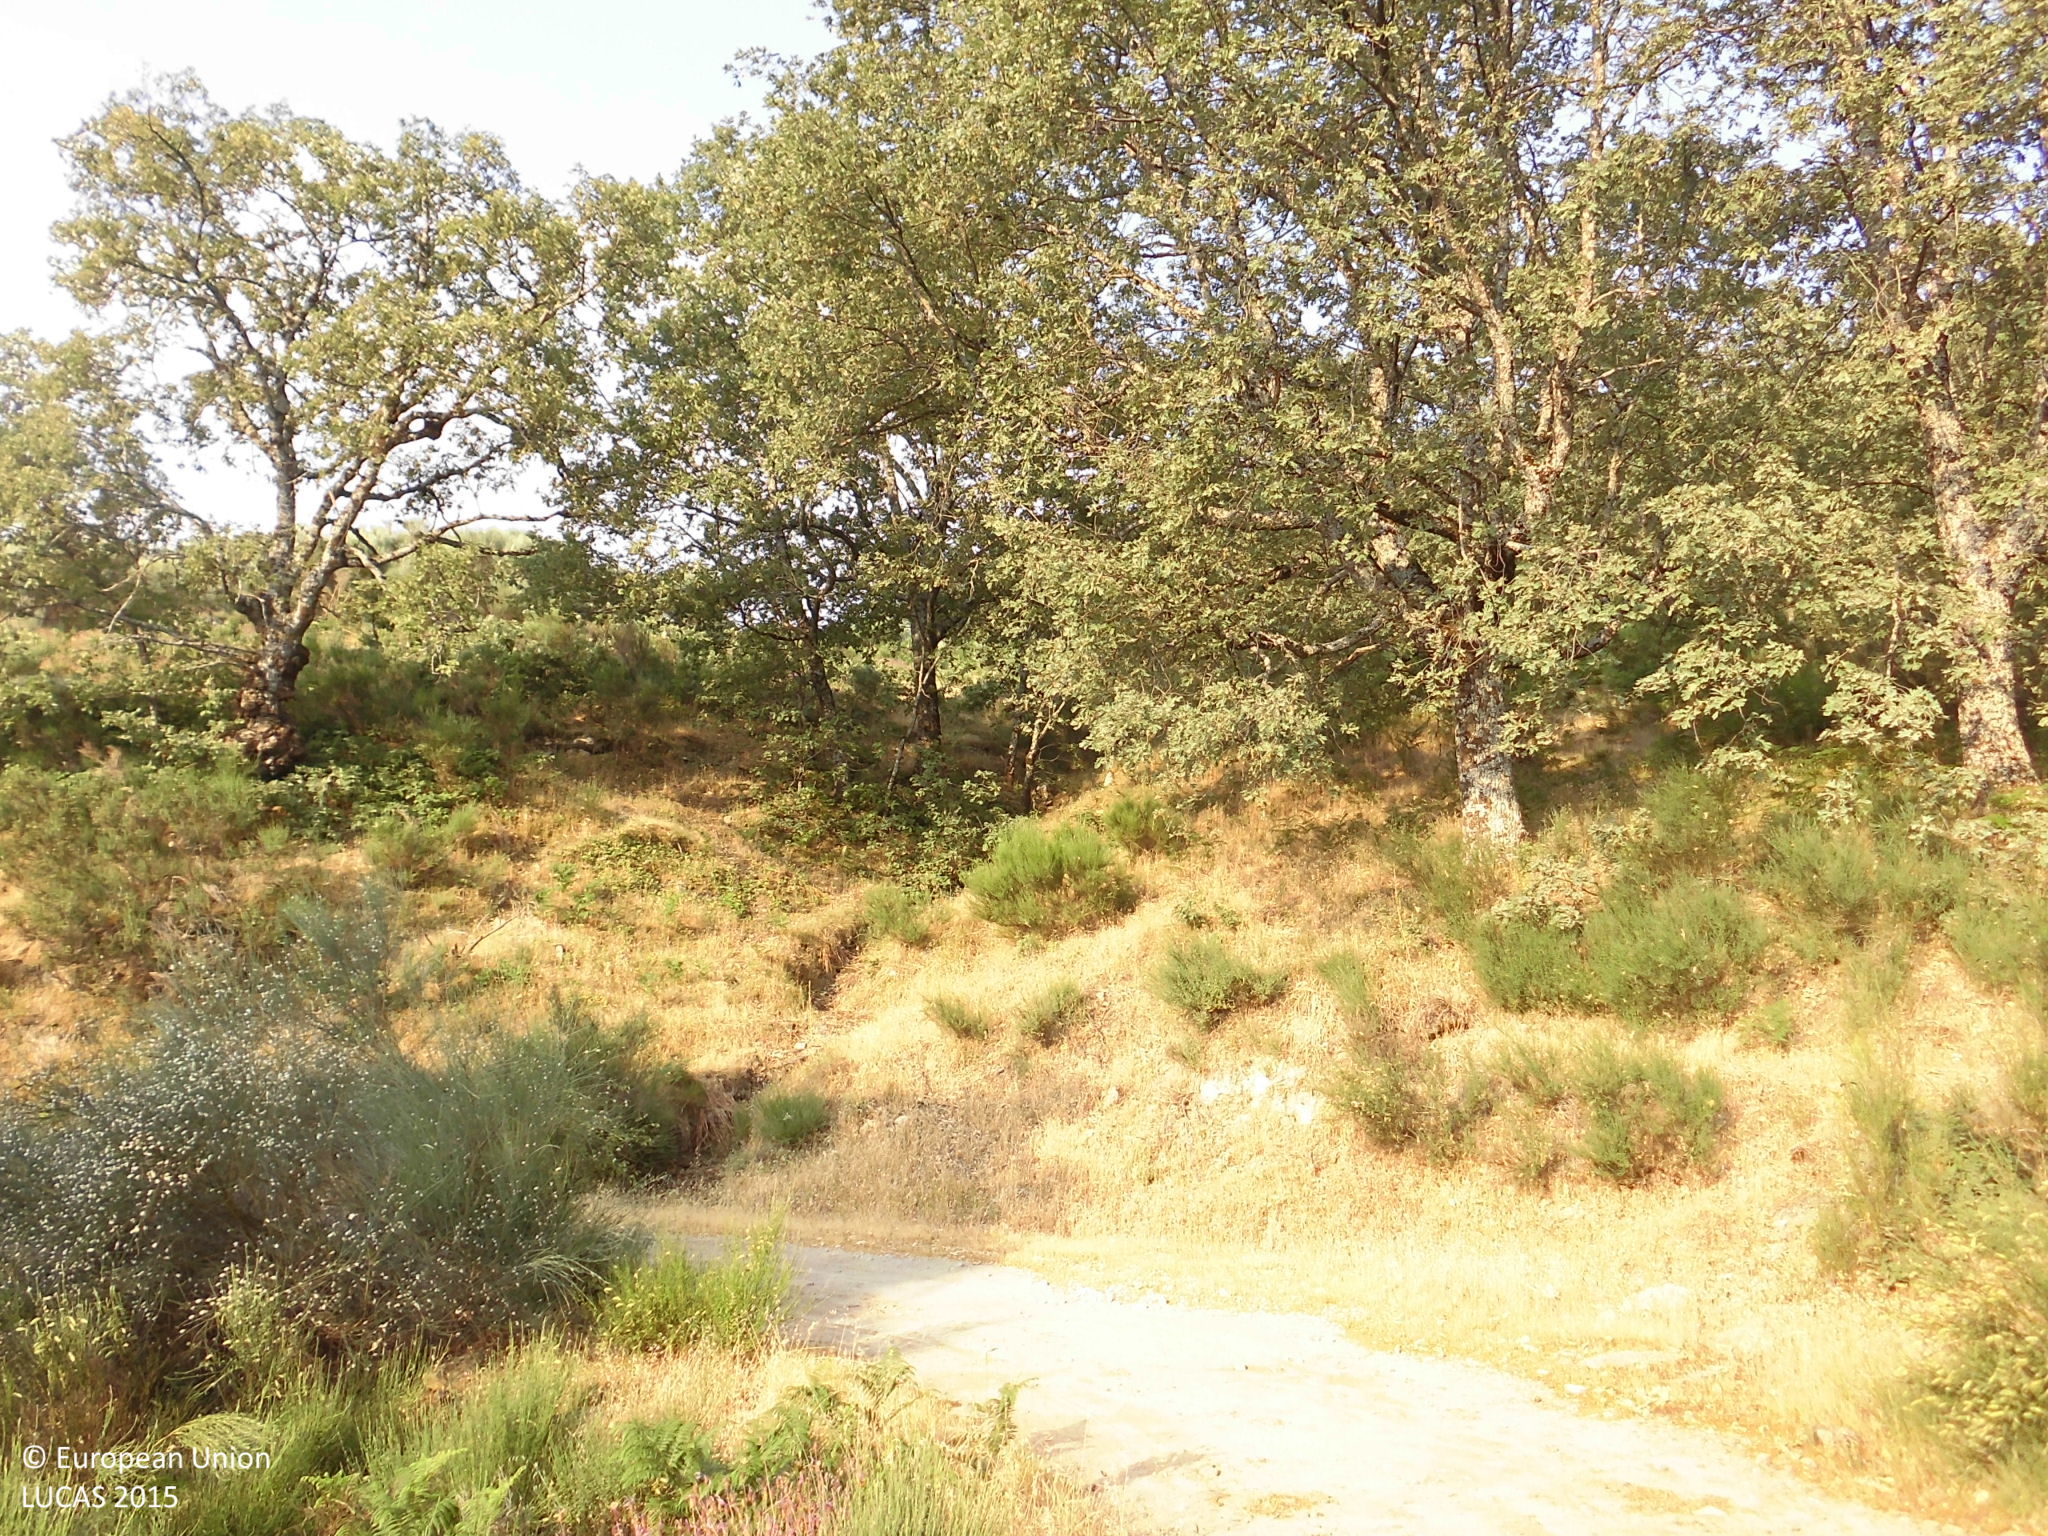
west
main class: Woodland
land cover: Broadleaved woodland
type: thermophilous deciduous forest
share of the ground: 25 - 50 %
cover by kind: broadleaved forest trees 45 %, shrubs 25 %, herbaceous plants 25 %, lichens and mosses 5 %
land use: Forestry
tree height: > 5 m
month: June
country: ES
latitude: 40.1506
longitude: -5.7143
